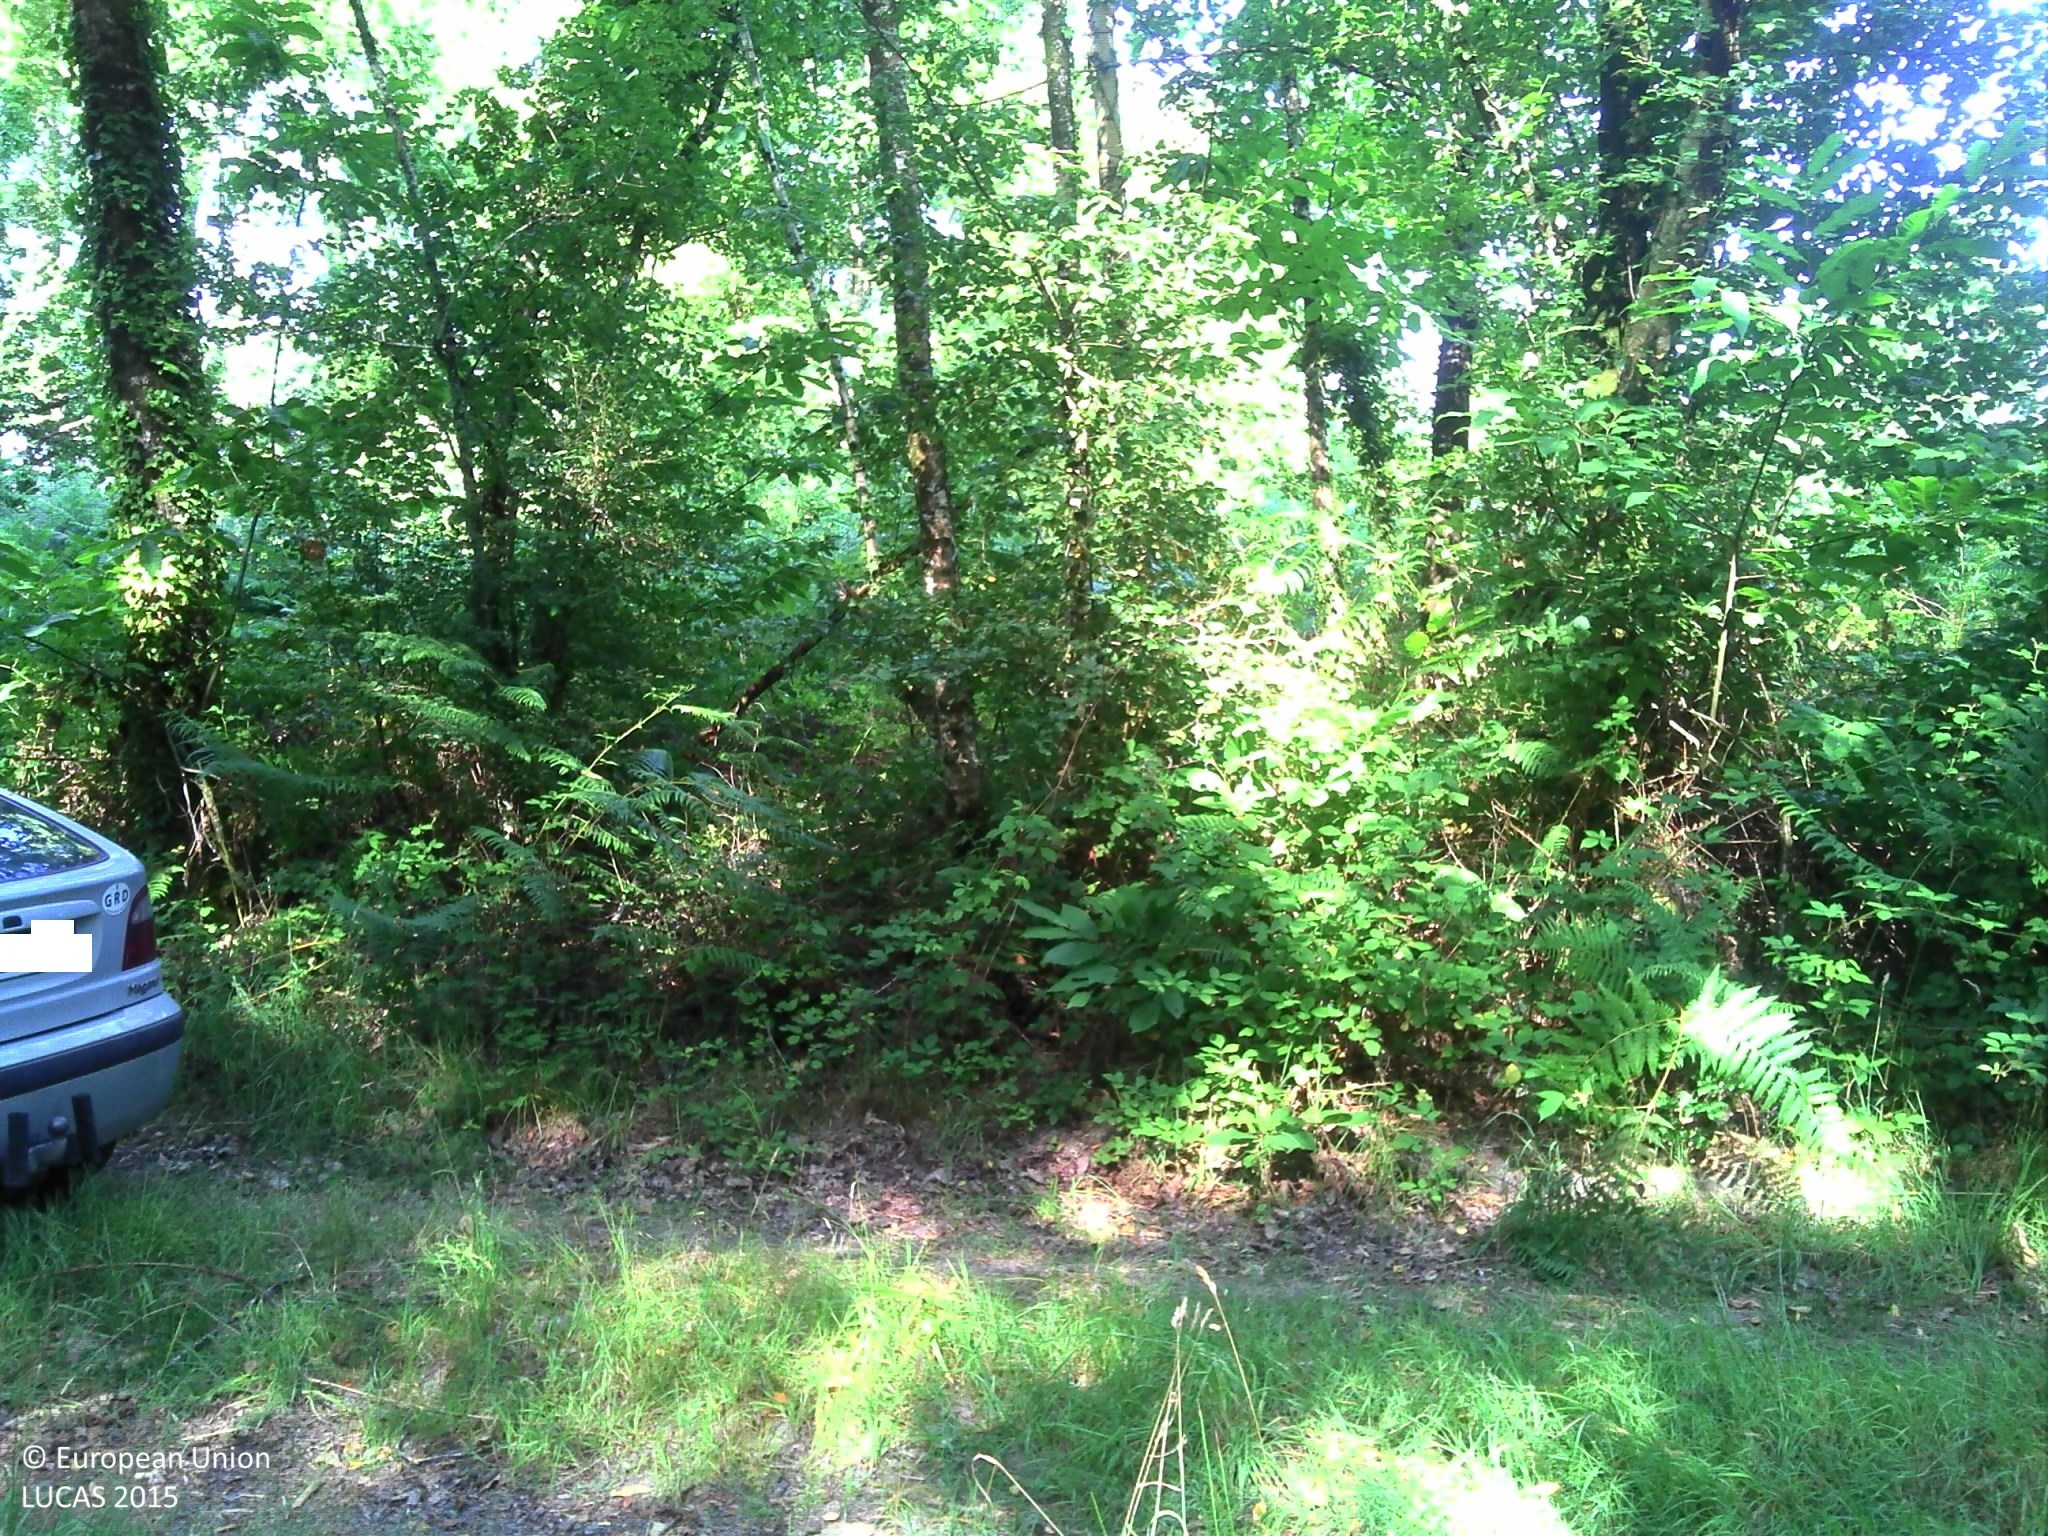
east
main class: Woodland
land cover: Broadleaved woodland
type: mesophytic deciduous forest
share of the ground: > 75 %
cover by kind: broadleaved forest trees 80 %, shrubs 10 %, herbaceous plants 10 %
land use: Forestry
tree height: > 5 m
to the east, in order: Broadleaved woodland; Tracks; Broadleaved woodland; Maize; Grassland without tree/shrub cover; Shruby margins; Tracks; Grass margins; Lines of trees
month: July
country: FR
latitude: 47.7847
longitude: -3.2447
